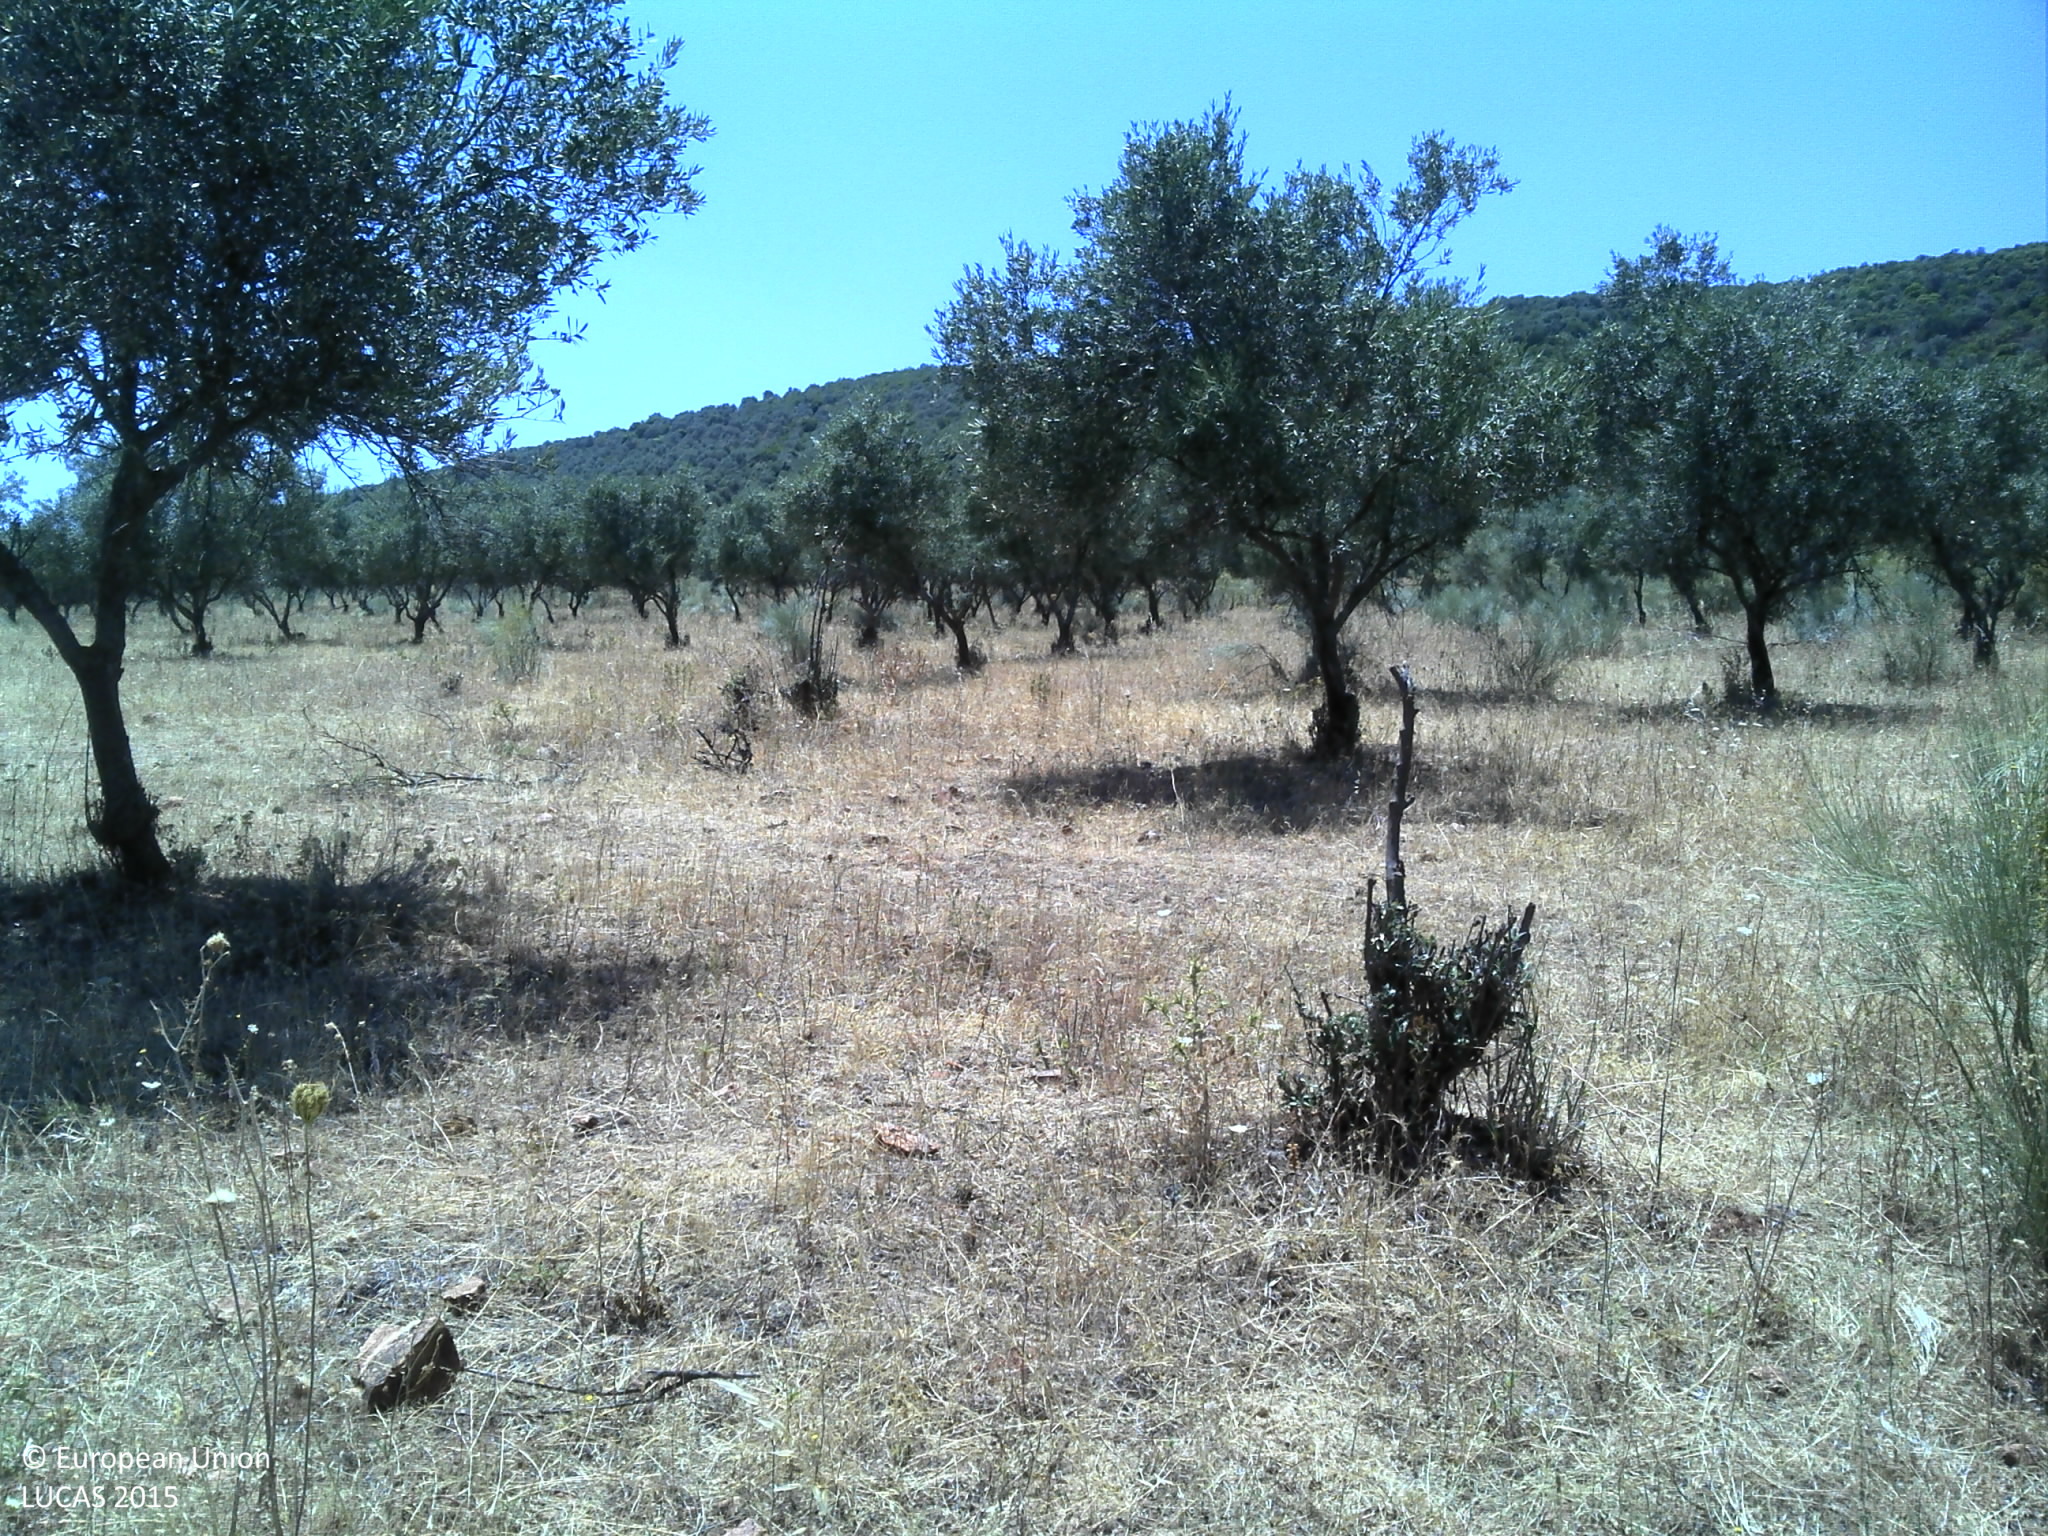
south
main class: Cropland
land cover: Olive groves
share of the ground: 25 - 50 %
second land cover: Grassland without tree/shrub cover
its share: 50 - 75 %
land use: Agriculture (excluding fallow land and kitchen gardens)
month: June
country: PT
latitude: 38.0519
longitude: -7.3036
